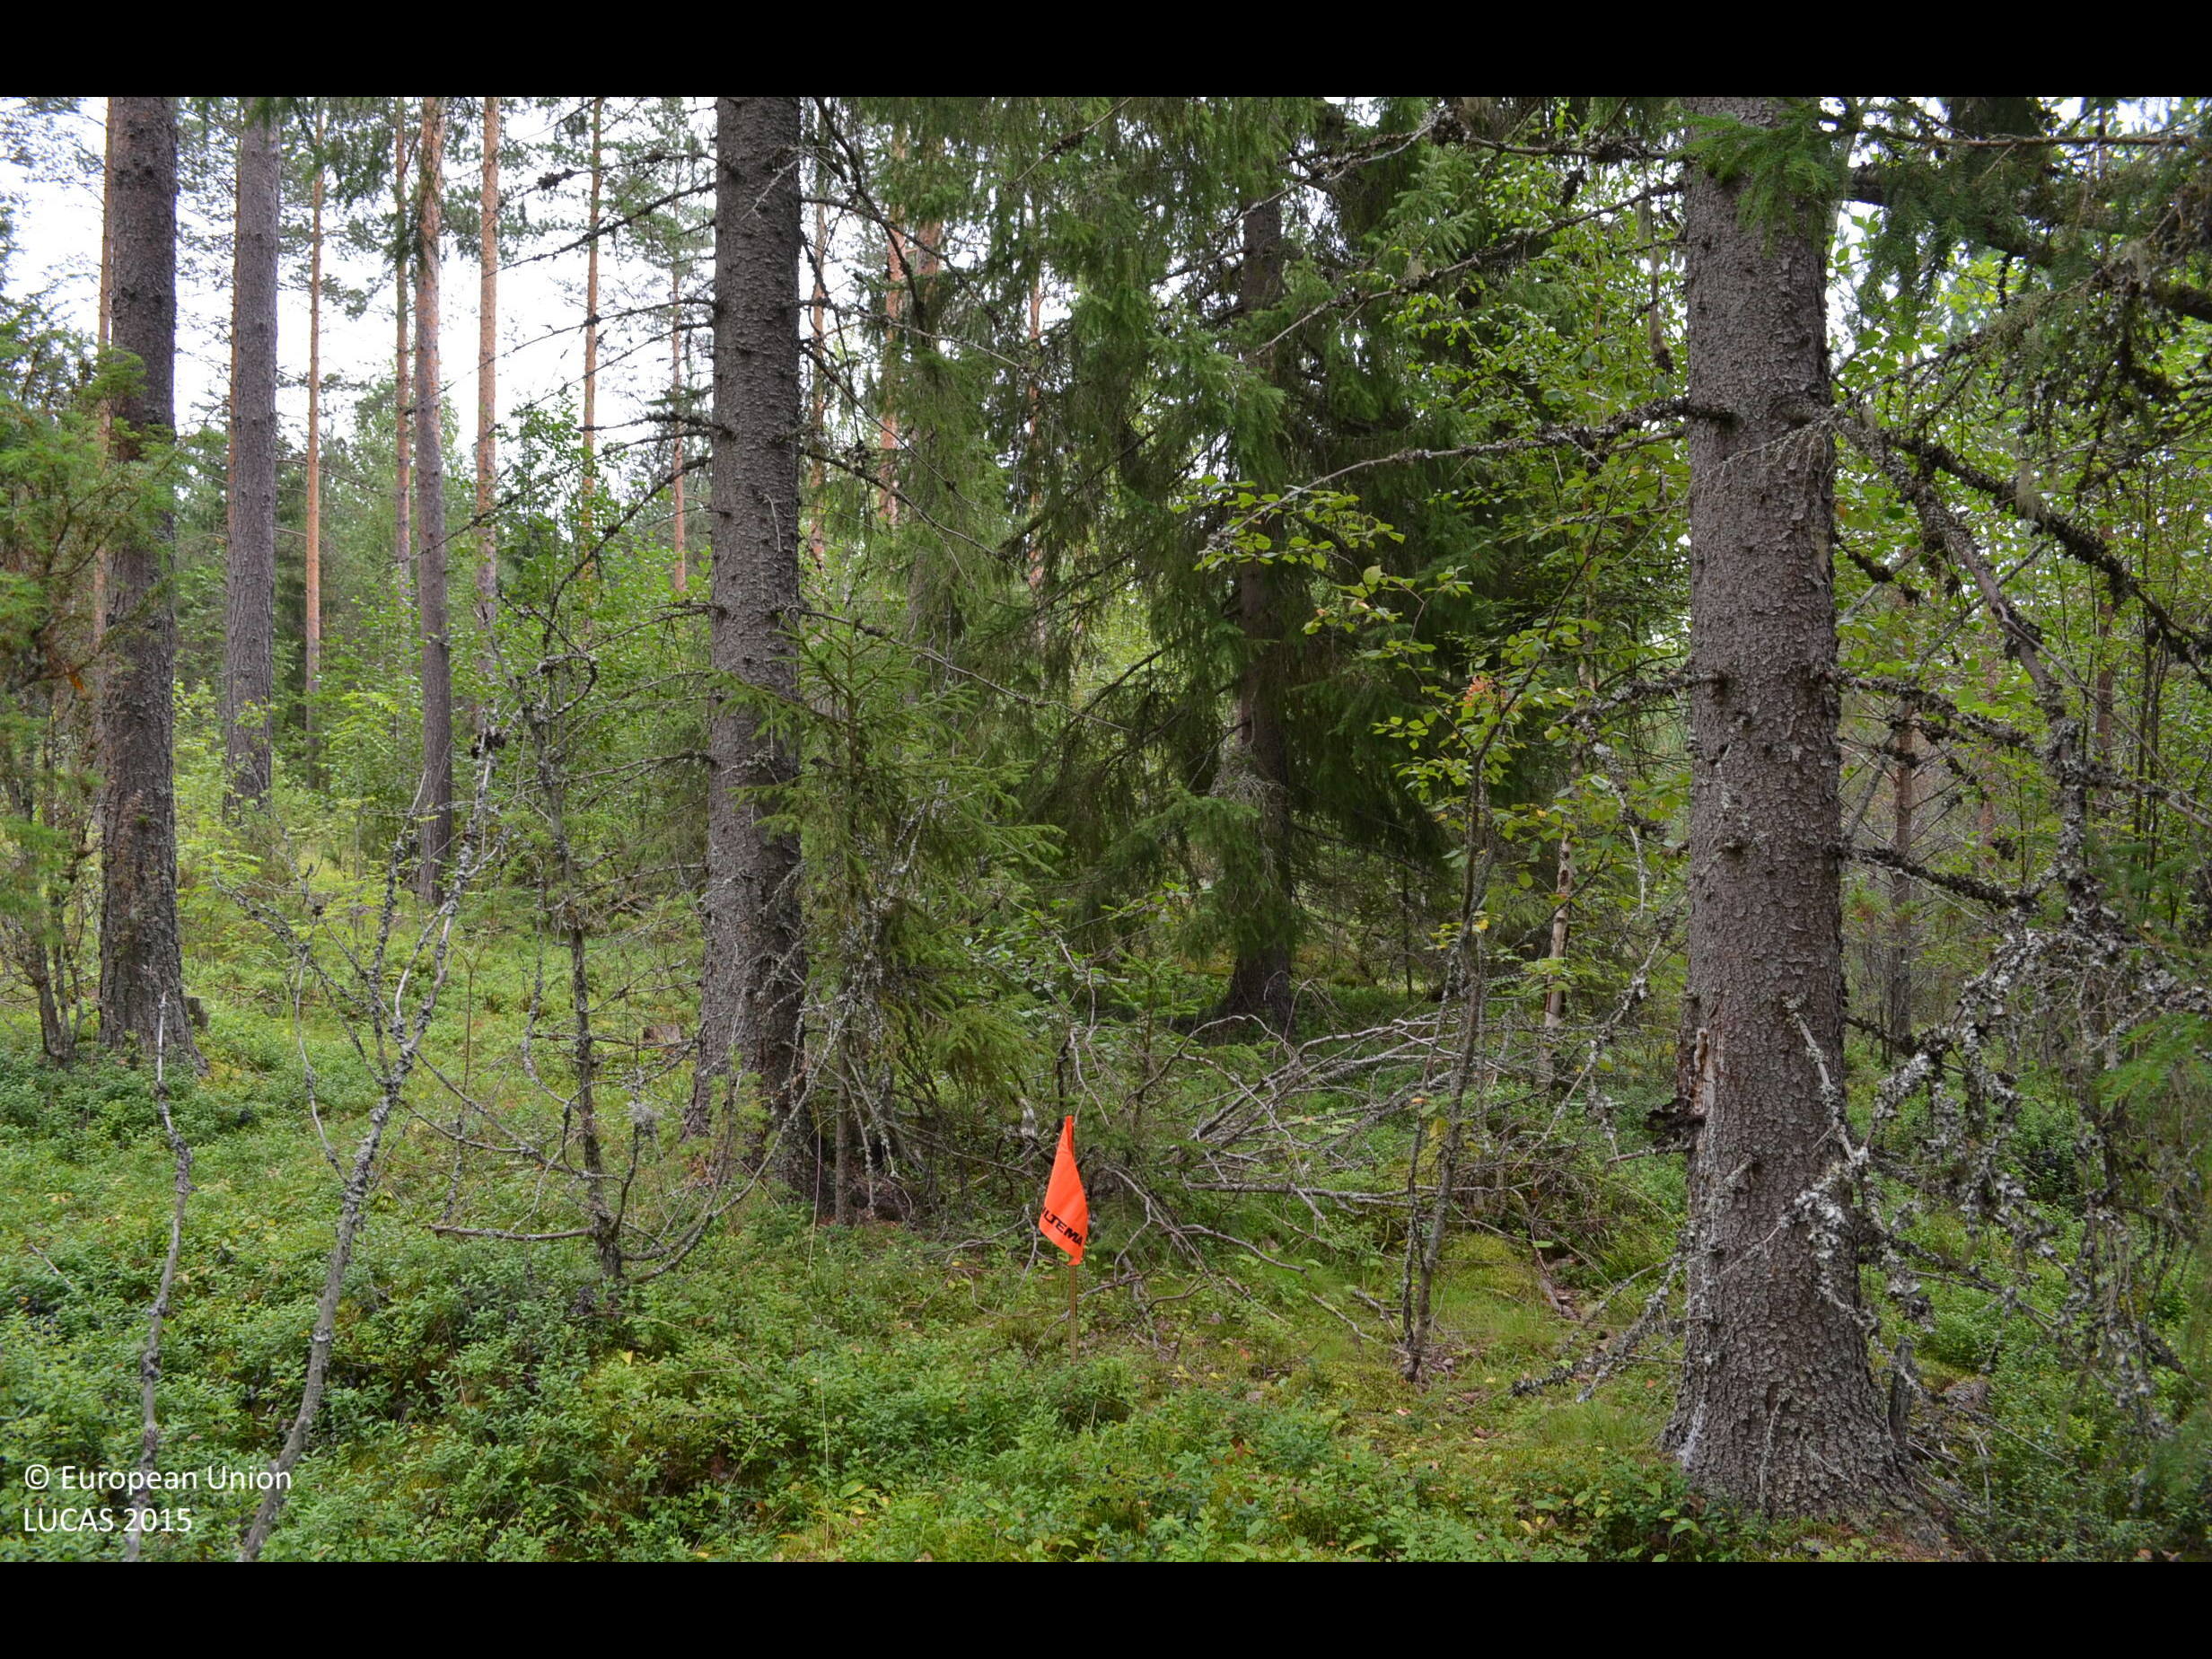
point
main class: Woodland
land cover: Other mixed woodland
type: boreal forest
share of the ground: > 75 %
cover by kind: coniferous forest trees 60 %, broadleaved forest trees 20 %, shrubs 15 %, lichens and mosses 5 %
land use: Forestry
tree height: > 5 m
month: August
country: FI
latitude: 62.2153
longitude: 24.3381
